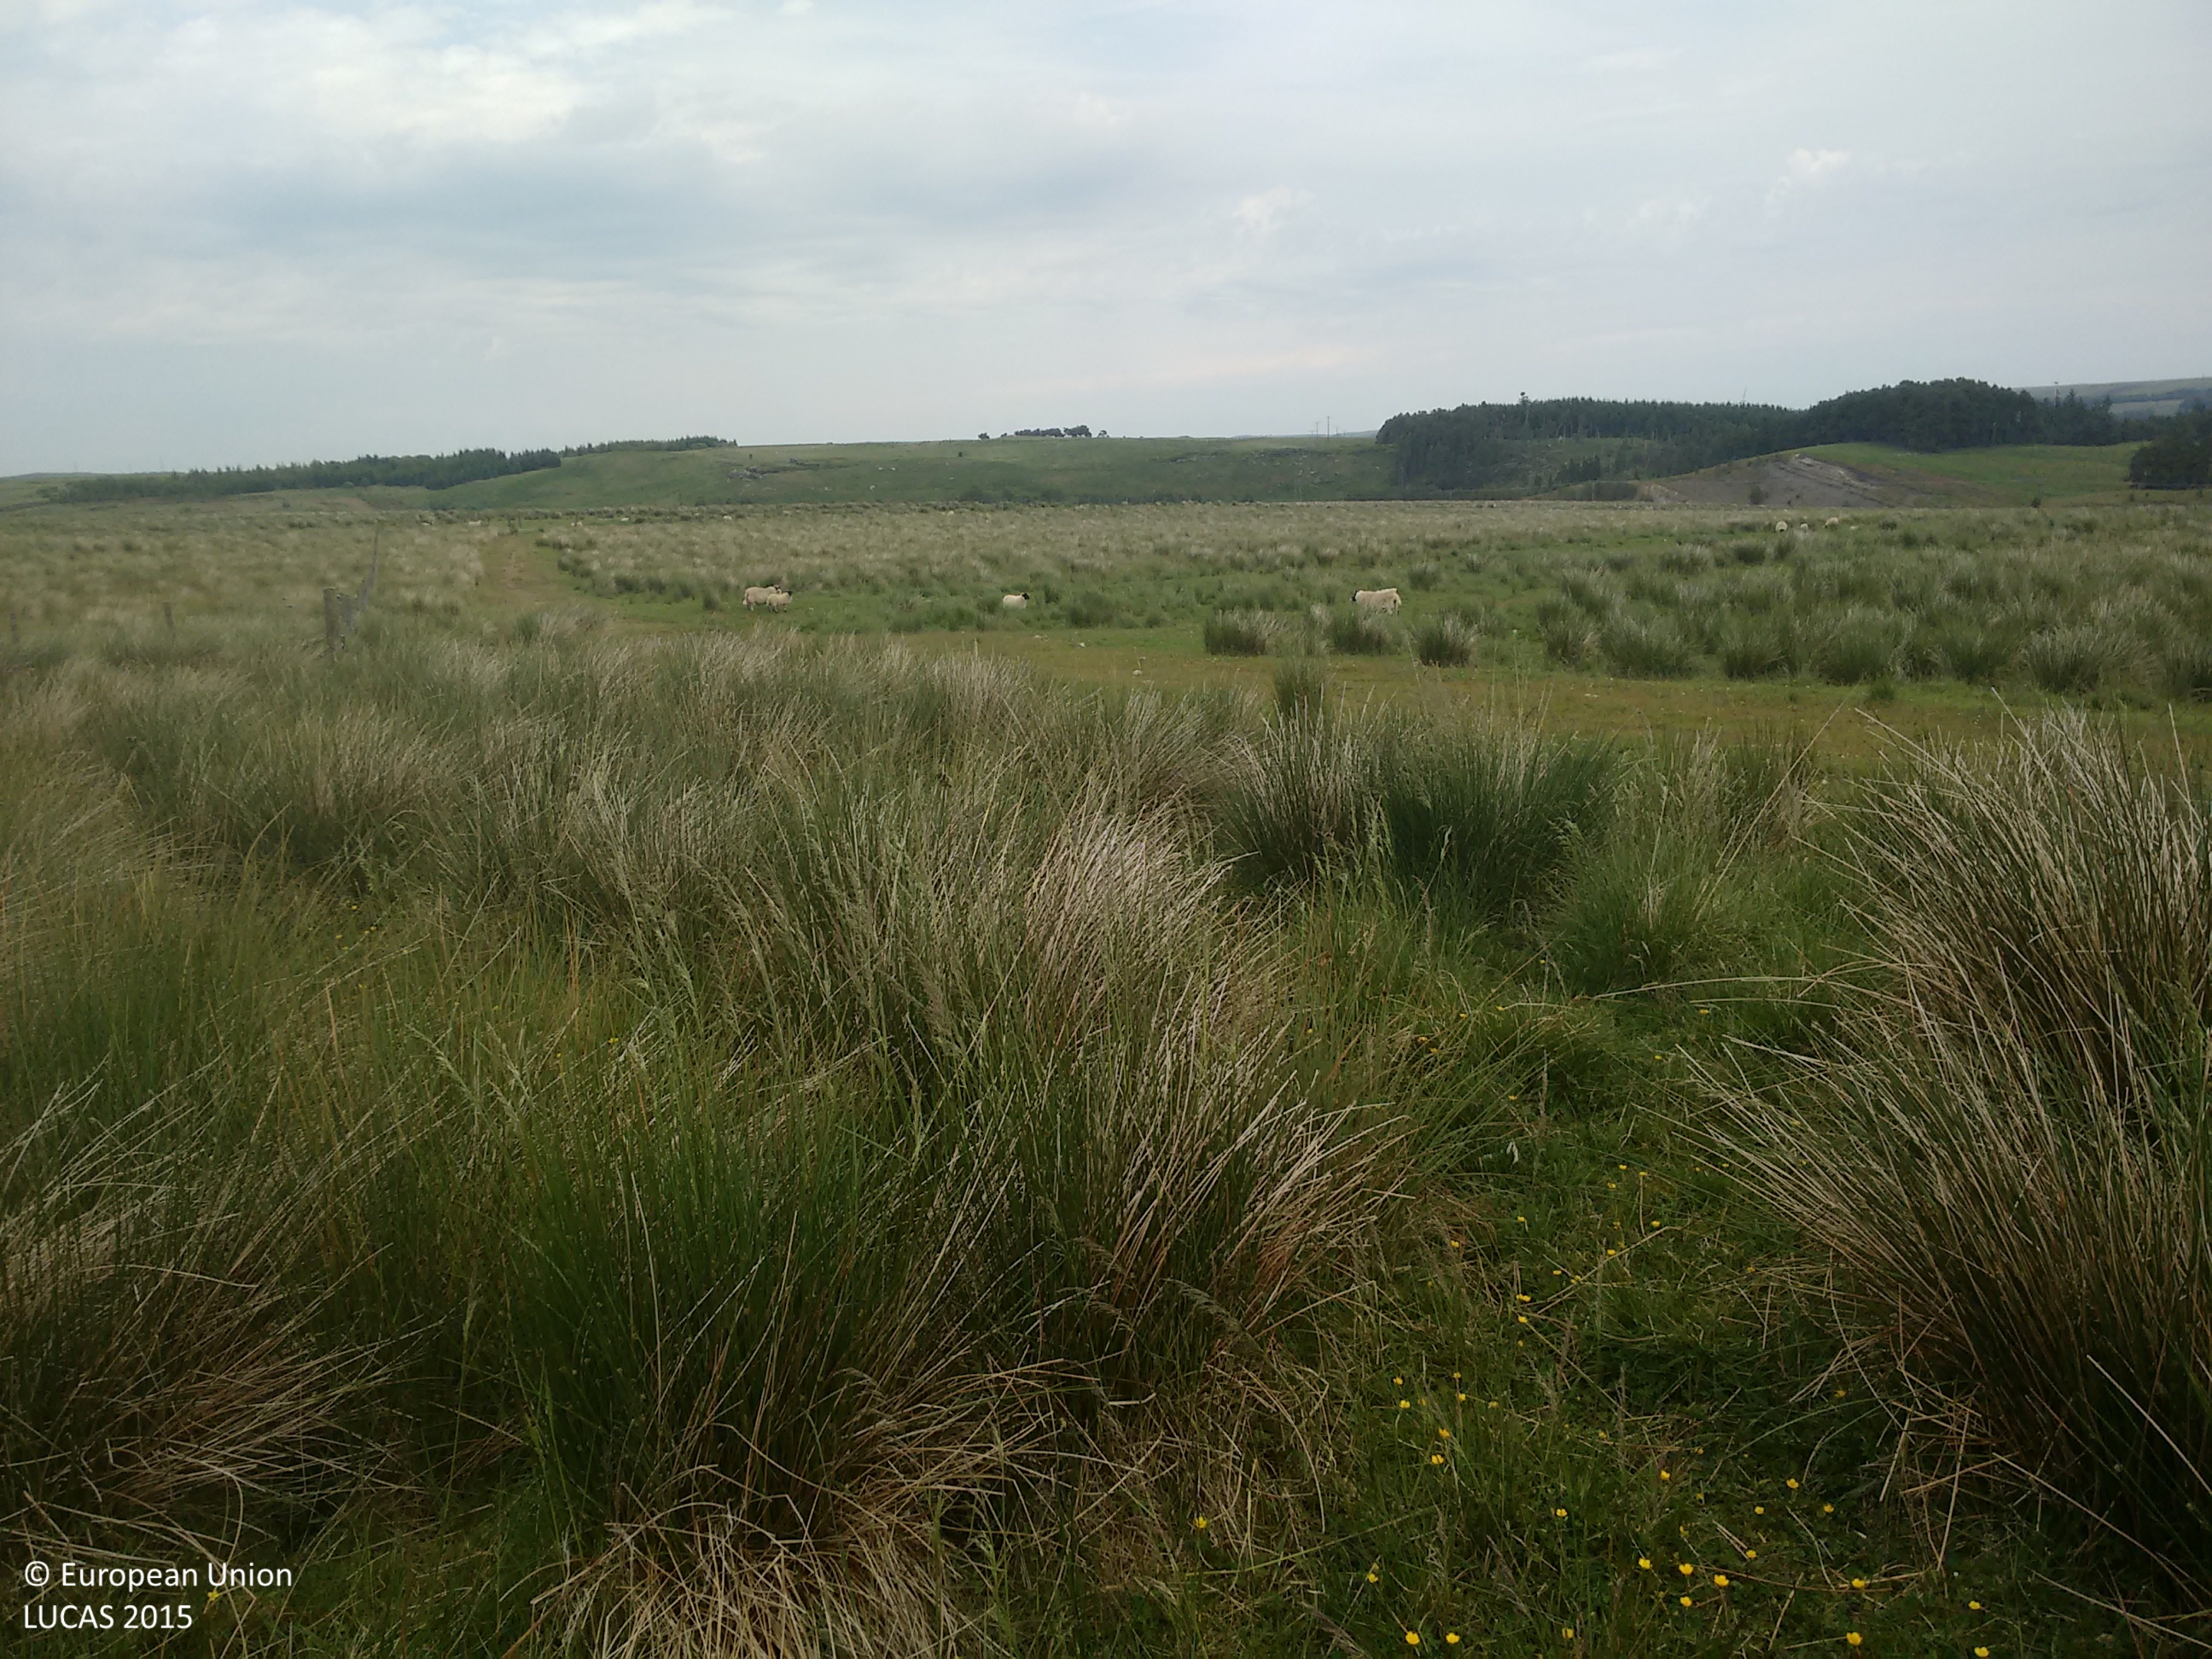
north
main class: Grassland
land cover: Grassland without tree/shrub cover
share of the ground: > 75 %
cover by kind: herbaceous plants 75 %, lichens and mosses 25 %
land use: Agriculture (excluding fallow land and kitchen gardens)
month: July
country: GB
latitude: 55.5757
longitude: -3.8695
